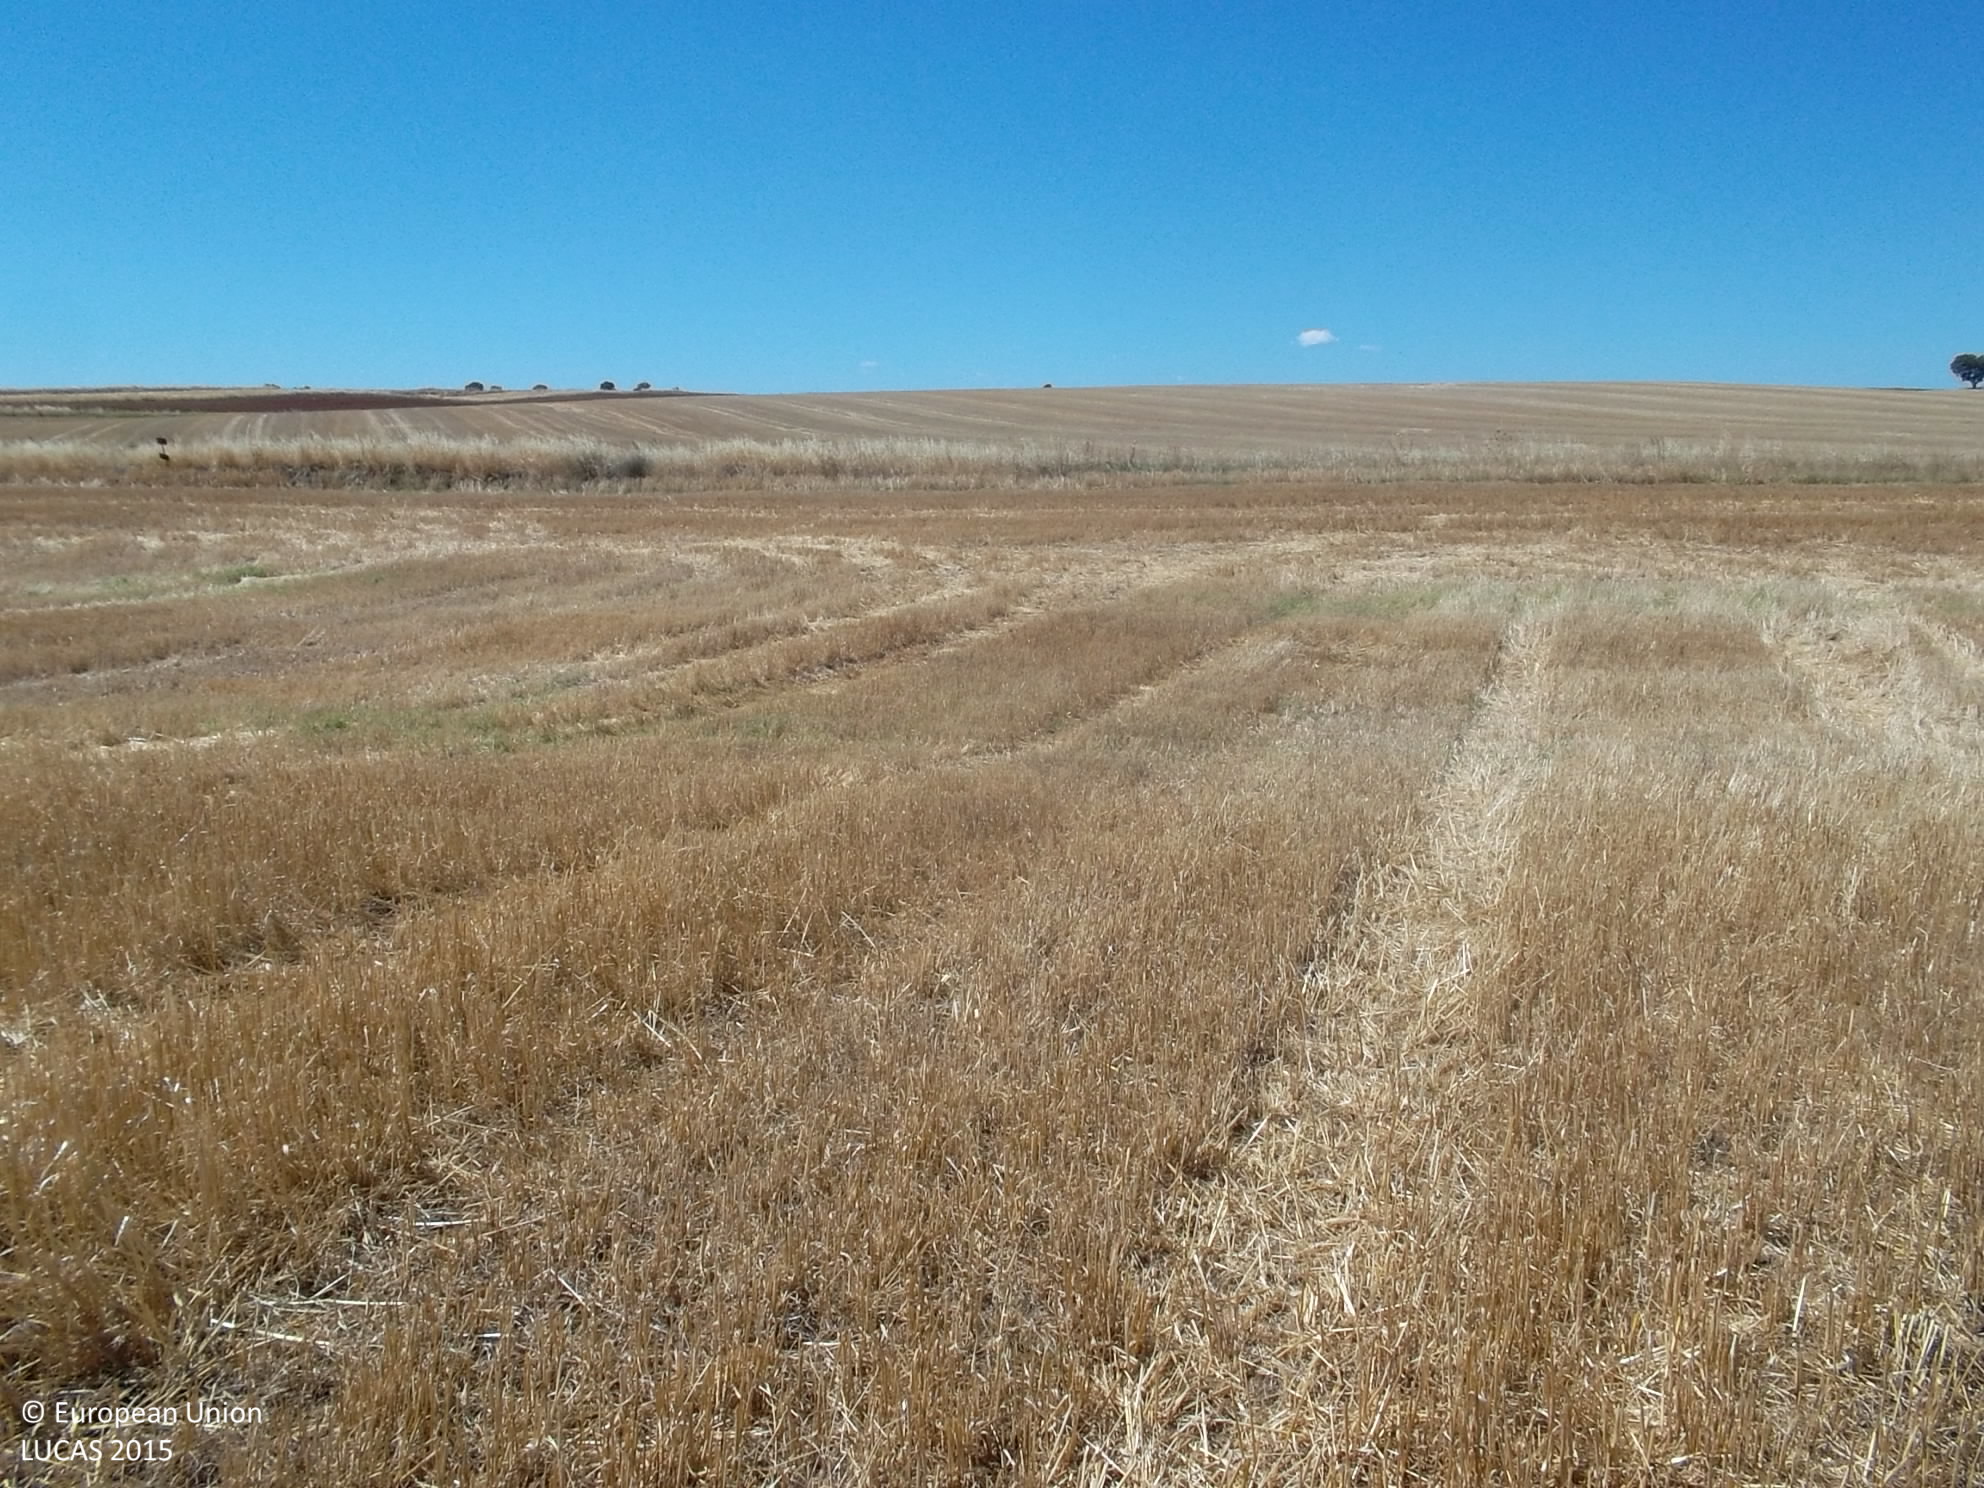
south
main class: Cropland
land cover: Barley
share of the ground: < 10 %
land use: Agriculture (excluding fallow land and kitchen gardens)
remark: Harvested field
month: July
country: ES
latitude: 38.4173
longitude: -5.7405
